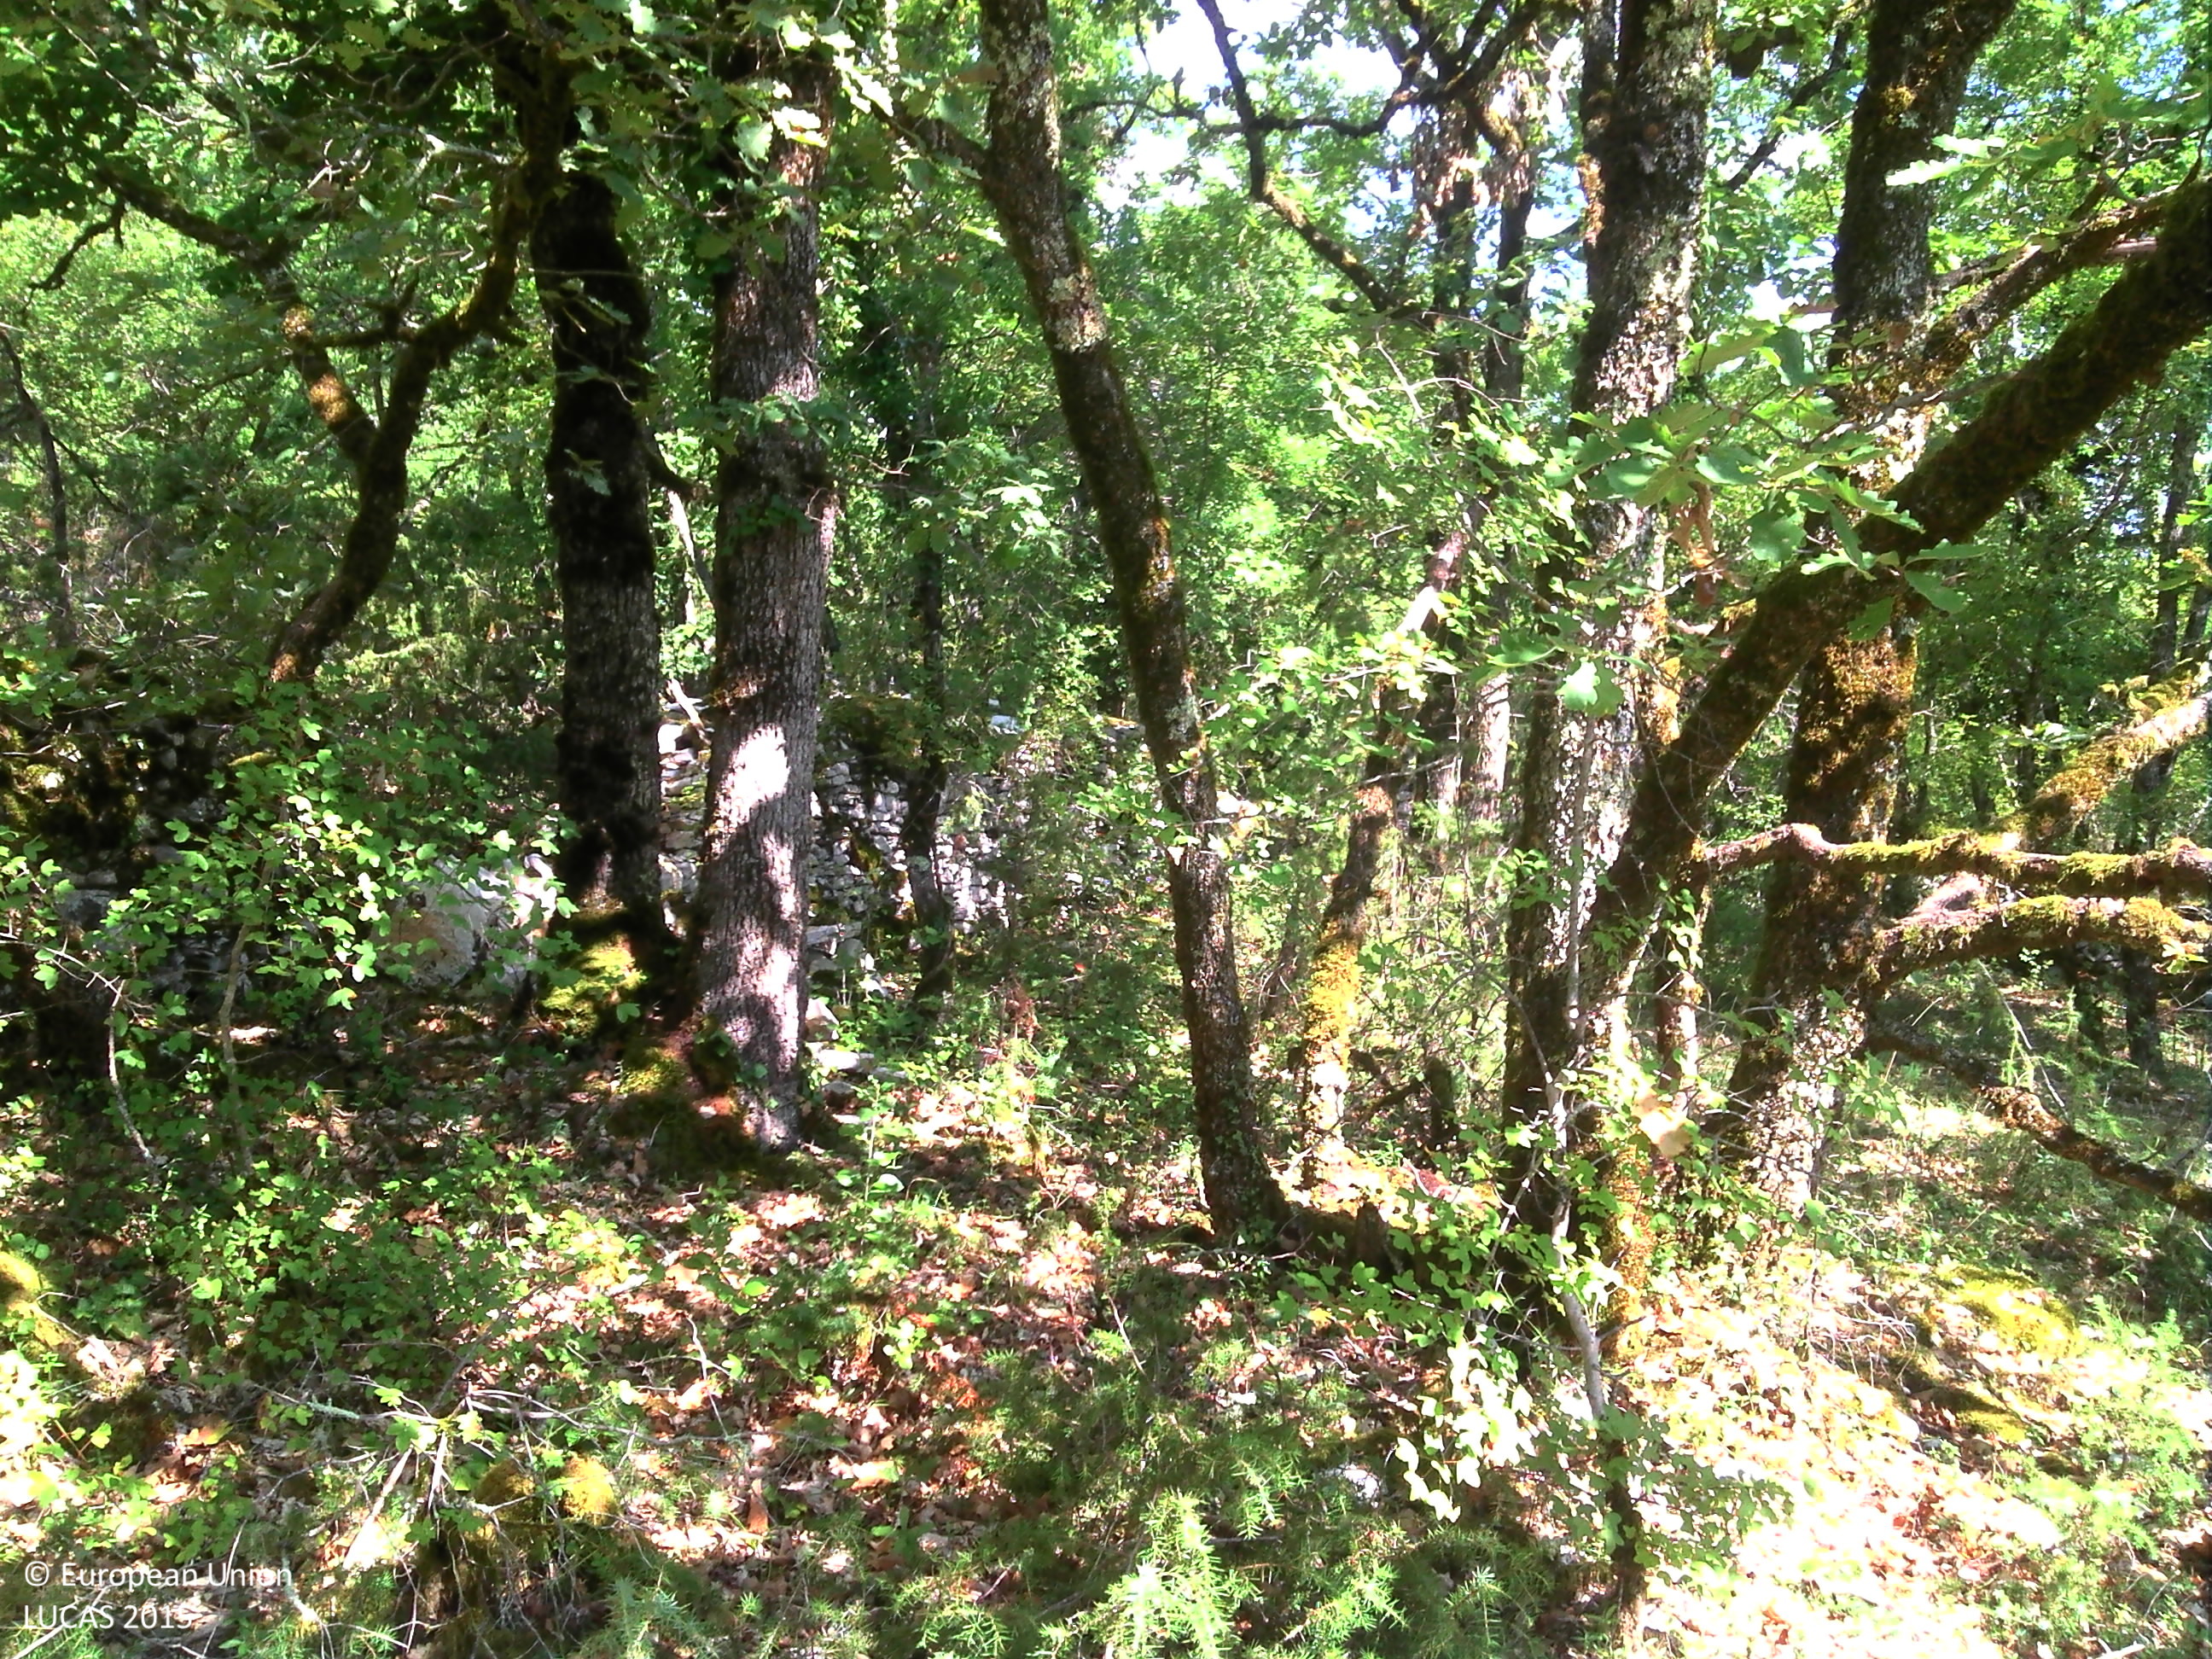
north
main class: Woodland
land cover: Broadleaved woodland
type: thermophilous deciduous forest
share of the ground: > 75 %
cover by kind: broadleaved forest trees 75 %, shrubs 10 %, unconsolidated bare surface 10 %, herbaceous plants 5 %
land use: Semi-natural and natural areas not in use
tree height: > 5 m
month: September
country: FR
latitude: 44.5892
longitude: 1.8244
